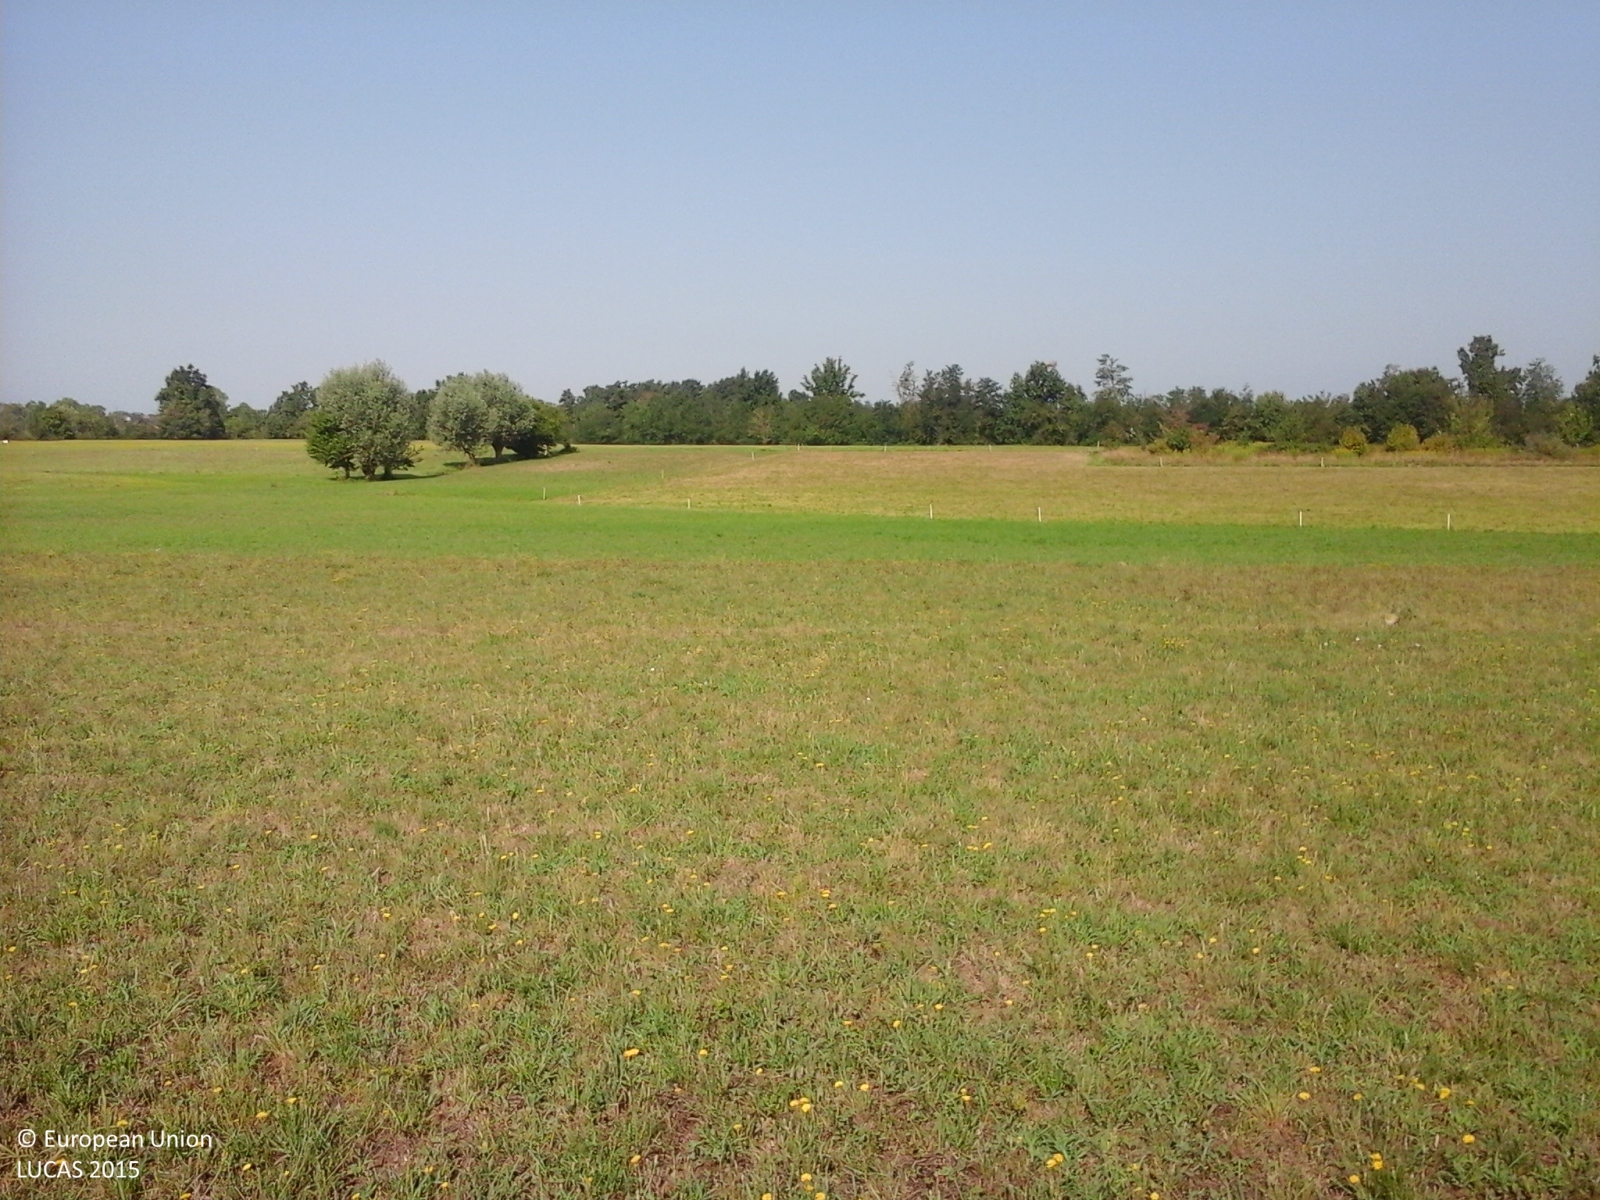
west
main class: Grassland
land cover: Grassland without tree/shrub cover
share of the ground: > 75 %
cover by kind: herbaceous plants 100 %
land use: Agriculture (excluding fallow land and kitchen gardens)
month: August
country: IT
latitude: 44.3991
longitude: 7.7824
